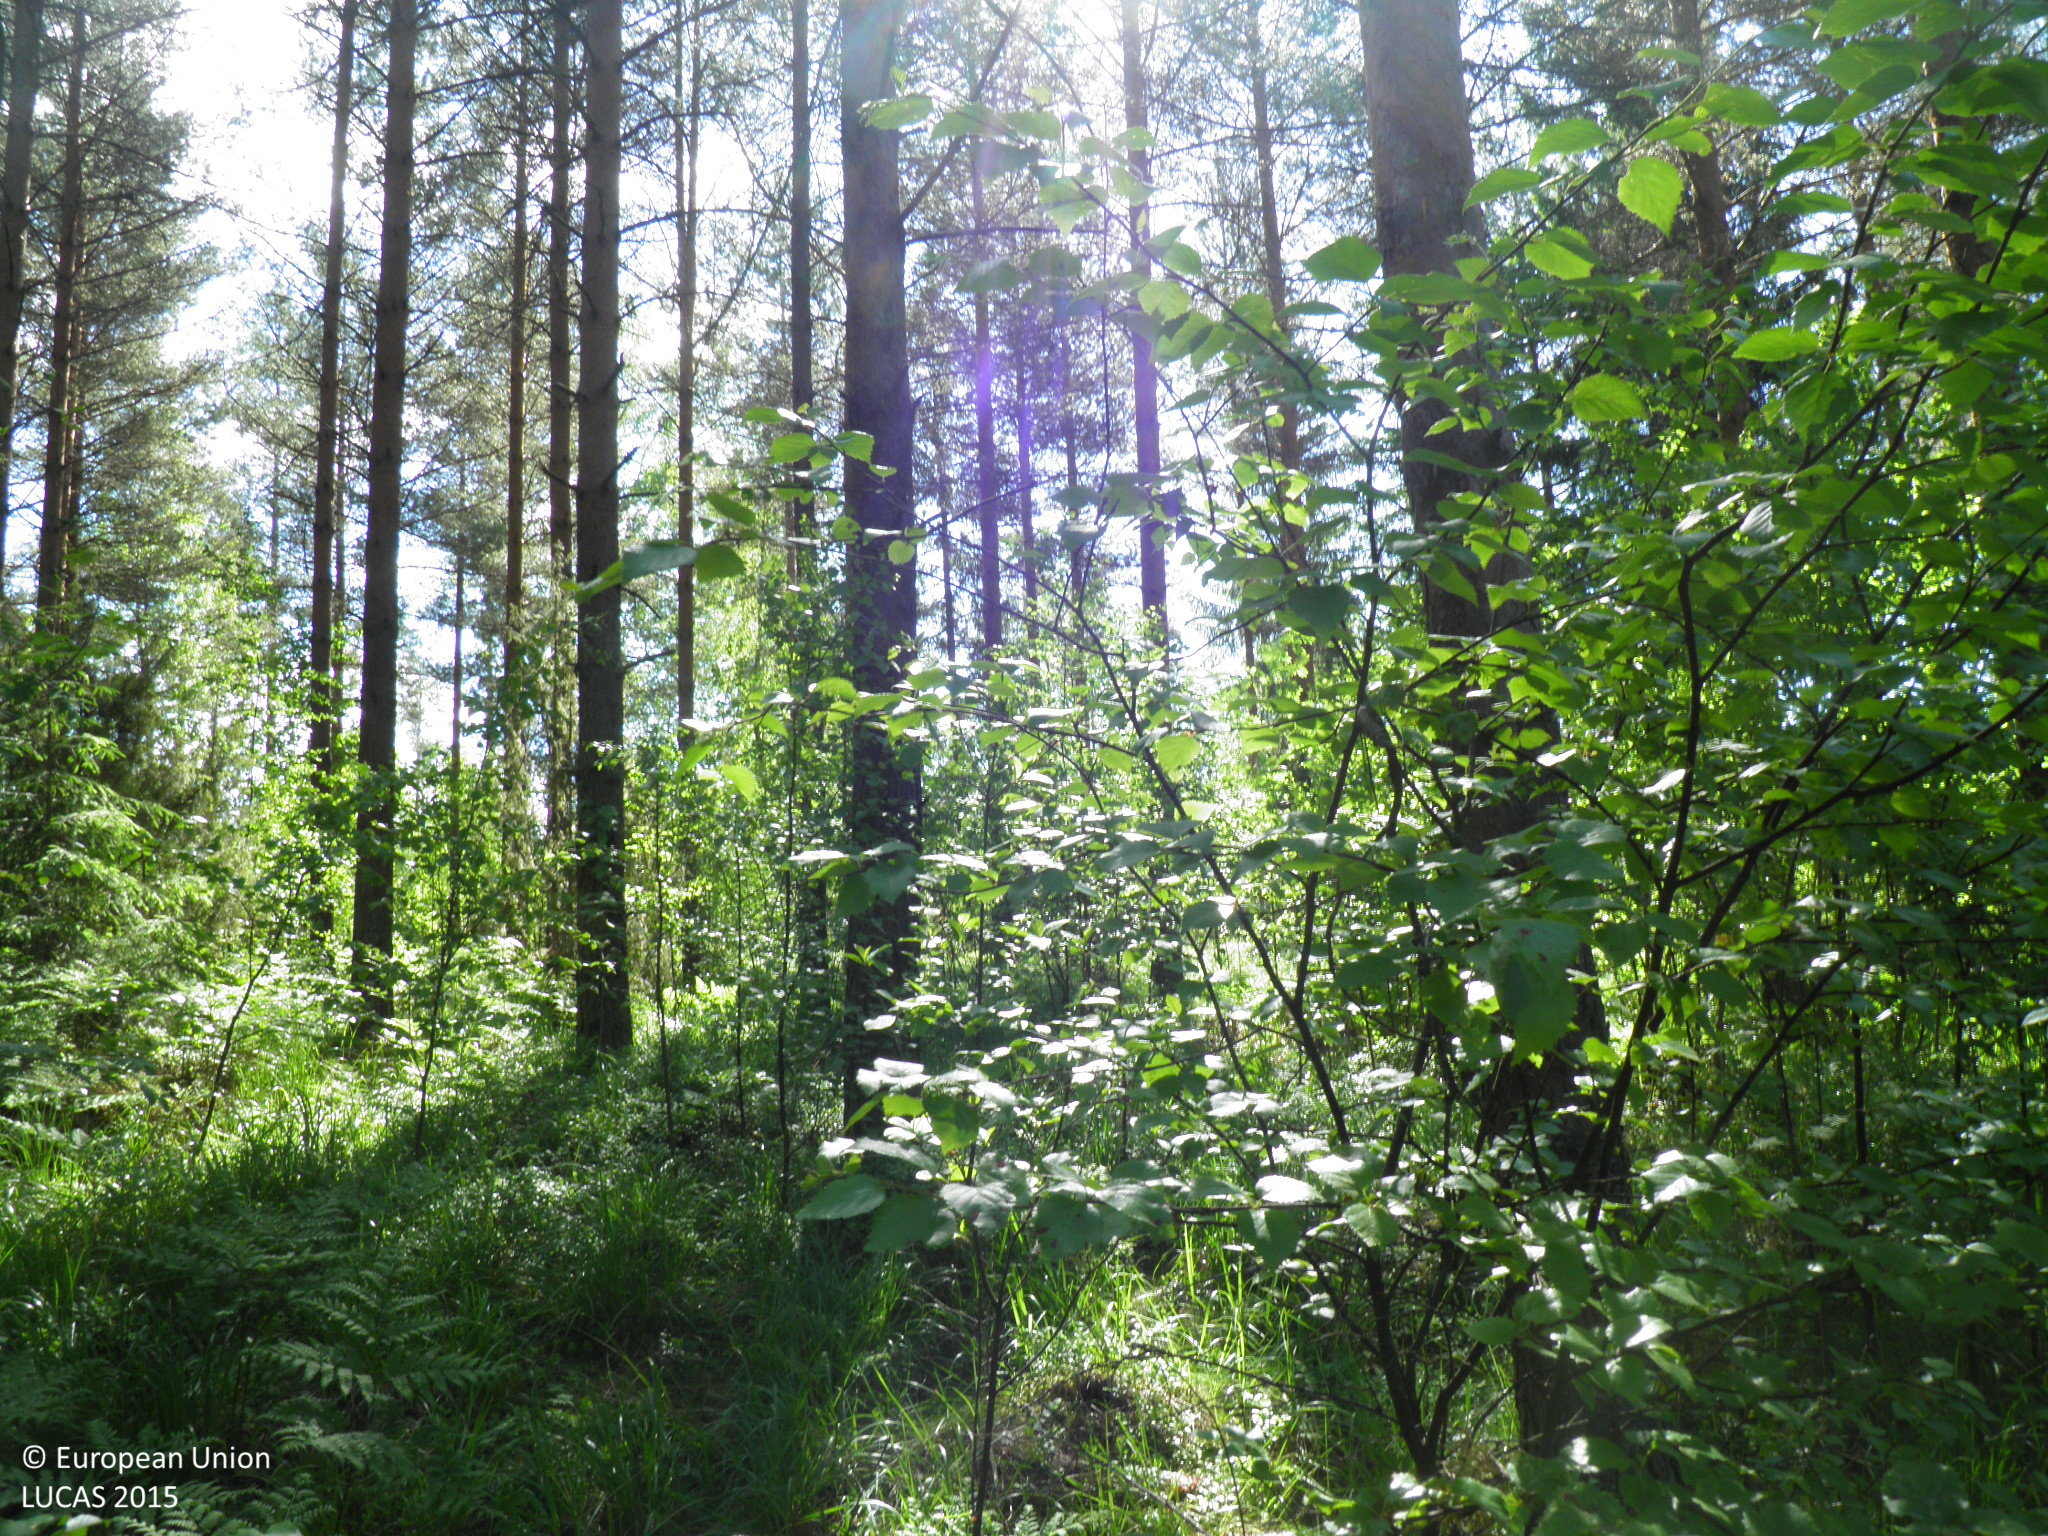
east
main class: Woodland
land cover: Pine dominated coniferous woodland
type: boreal forest
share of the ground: > 75 %
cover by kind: coniferous forest trees 70 %, broadleaved forest trees 10 %, herbaceous plants 10 %, lichens and mosses 10 %
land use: Forestry
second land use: Amenities, museums, leisure
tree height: > 5 m
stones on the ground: 25 - 50 %
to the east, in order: Pine dominated coniferous woodland; Tracks; Pine dominated mixed woodland; Tracks; Pine dominated mixed woodland; Ditches and canals; Pine dominated mixed woodland; Electric lines; Paved roads, cycling and walking lanes; Ditches and canals; Pine dominated coniferous woodland
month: June
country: FI
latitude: 60.4260
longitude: 22.6978
